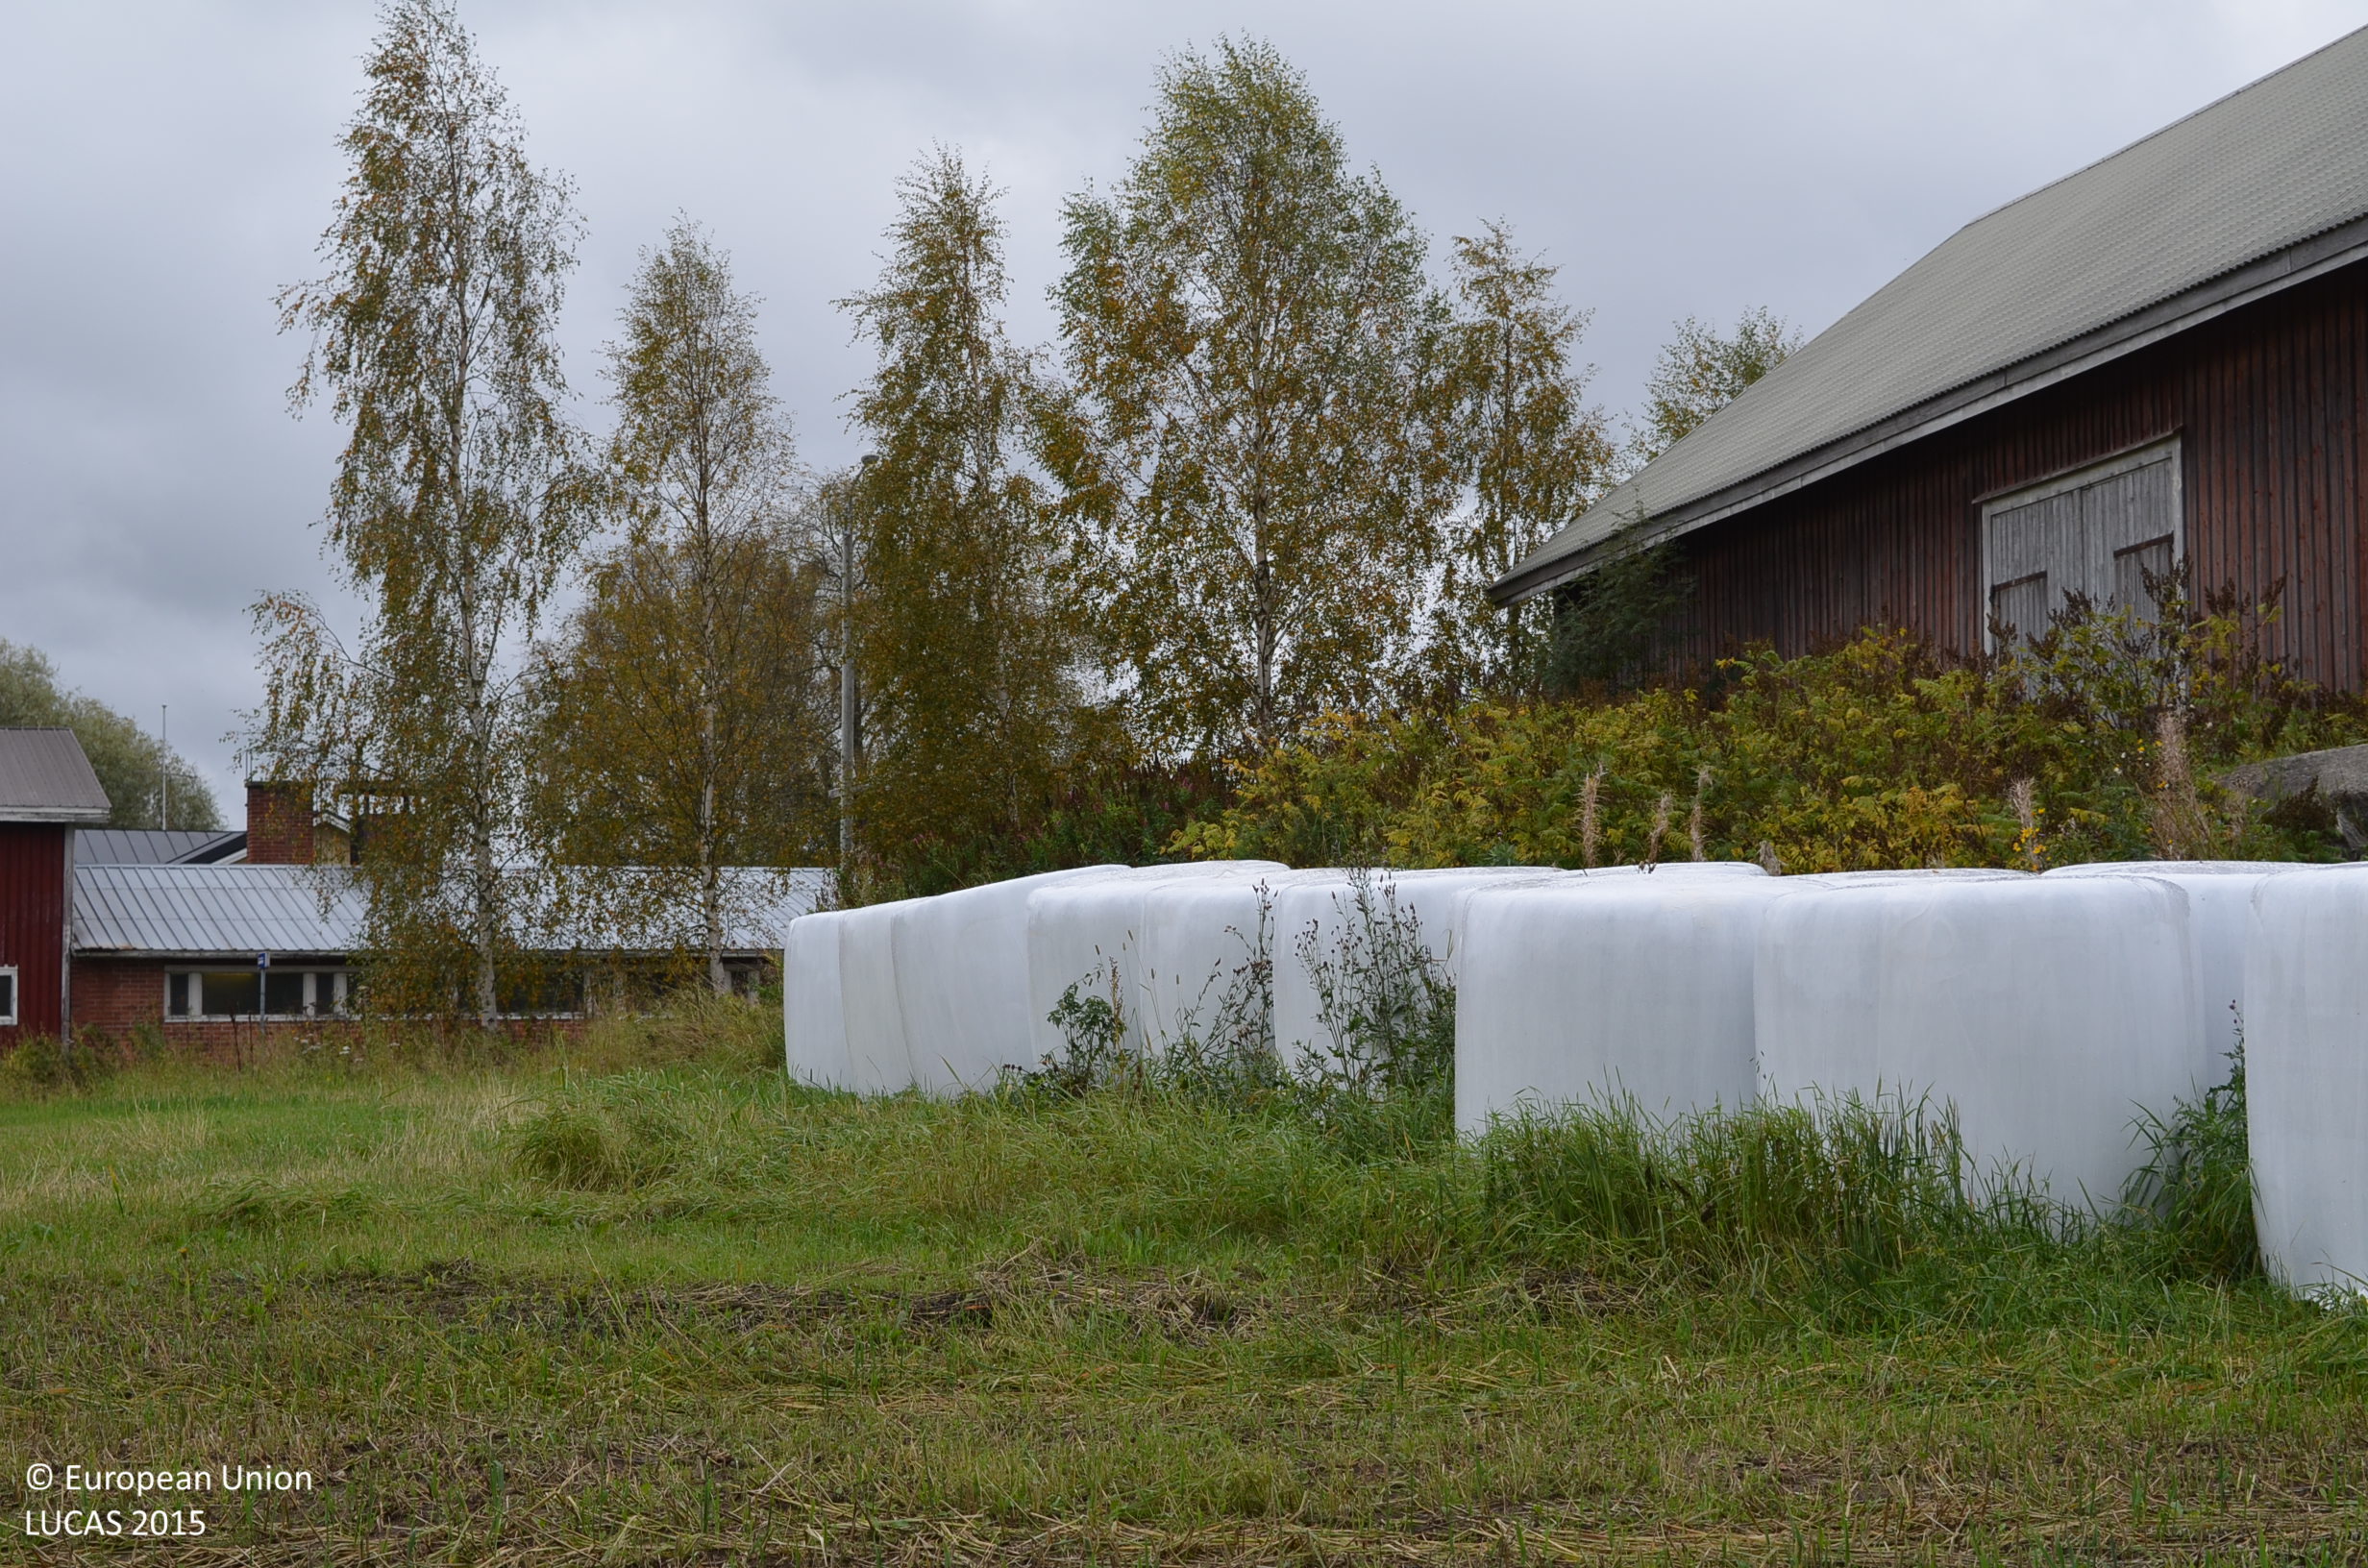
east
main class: Cropland
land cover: Oats
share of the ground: > 75 %
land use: Agriculture (excluding fallow land and kitchen gardens)
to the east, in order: Oats; Grassland without tree/shrub cover; Ditches and canals; Grass margins; Paved roads, cycling and walking lanes; Grass margins; Artificial constructions in urban areas; Grassland without tree/shrub cover; Fences; Grassland without tree/shrub cover; Electric lines; Grassland without tree/shrub cover
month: September
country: FI
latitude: 62.6317
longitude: 23.8220
